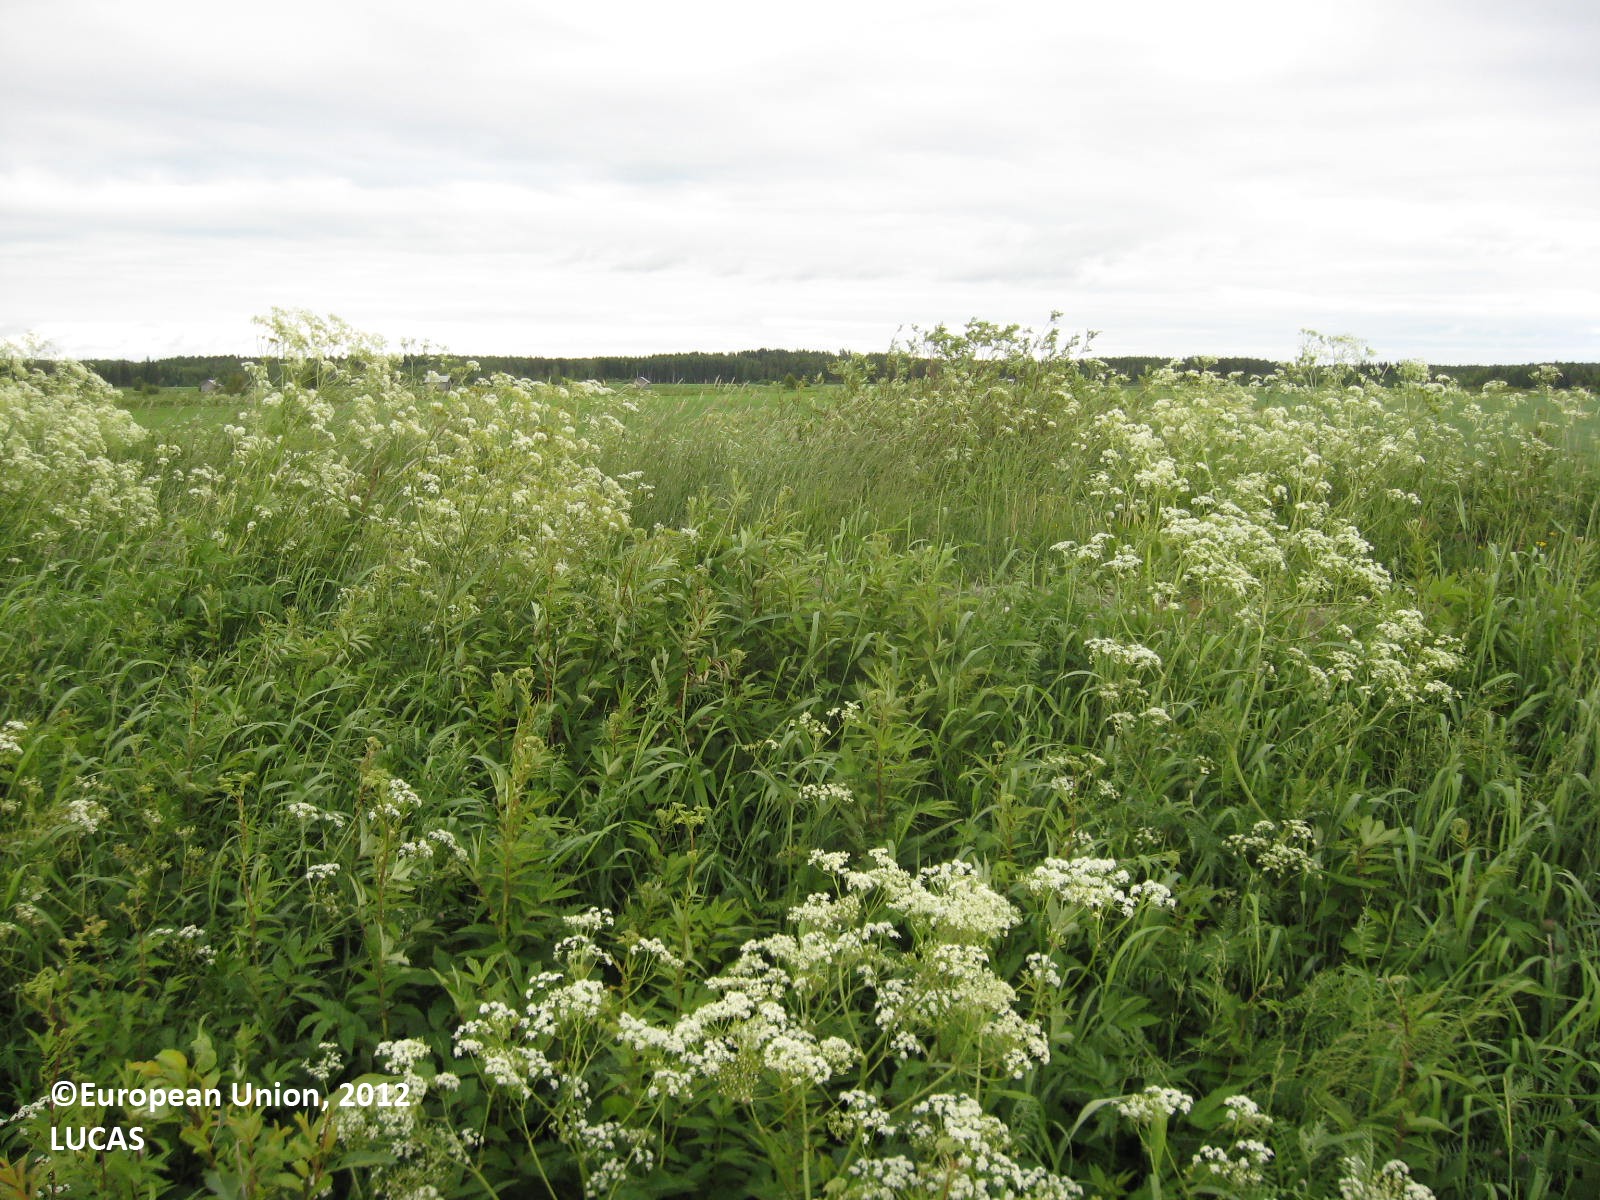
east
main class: Cropland
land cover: Barley
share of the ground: > 75 %
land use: Agriculture (excluding fallow land and kitchen gardens)
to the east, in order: Barley; Shruby margins; Ditches and canals; Shruby margins; Paved roads, cycling and walking lanes; Shrubland without tree cover; Ditches and canals; Shruby margins; Barley; Grass margins; Ditches and canals; Paved roads, cycling and walking lanes; Grass margins; Ditches and canals; Grass margins; Other bare soil
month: June
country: FI
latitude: 62.8681
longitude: 22.8132
